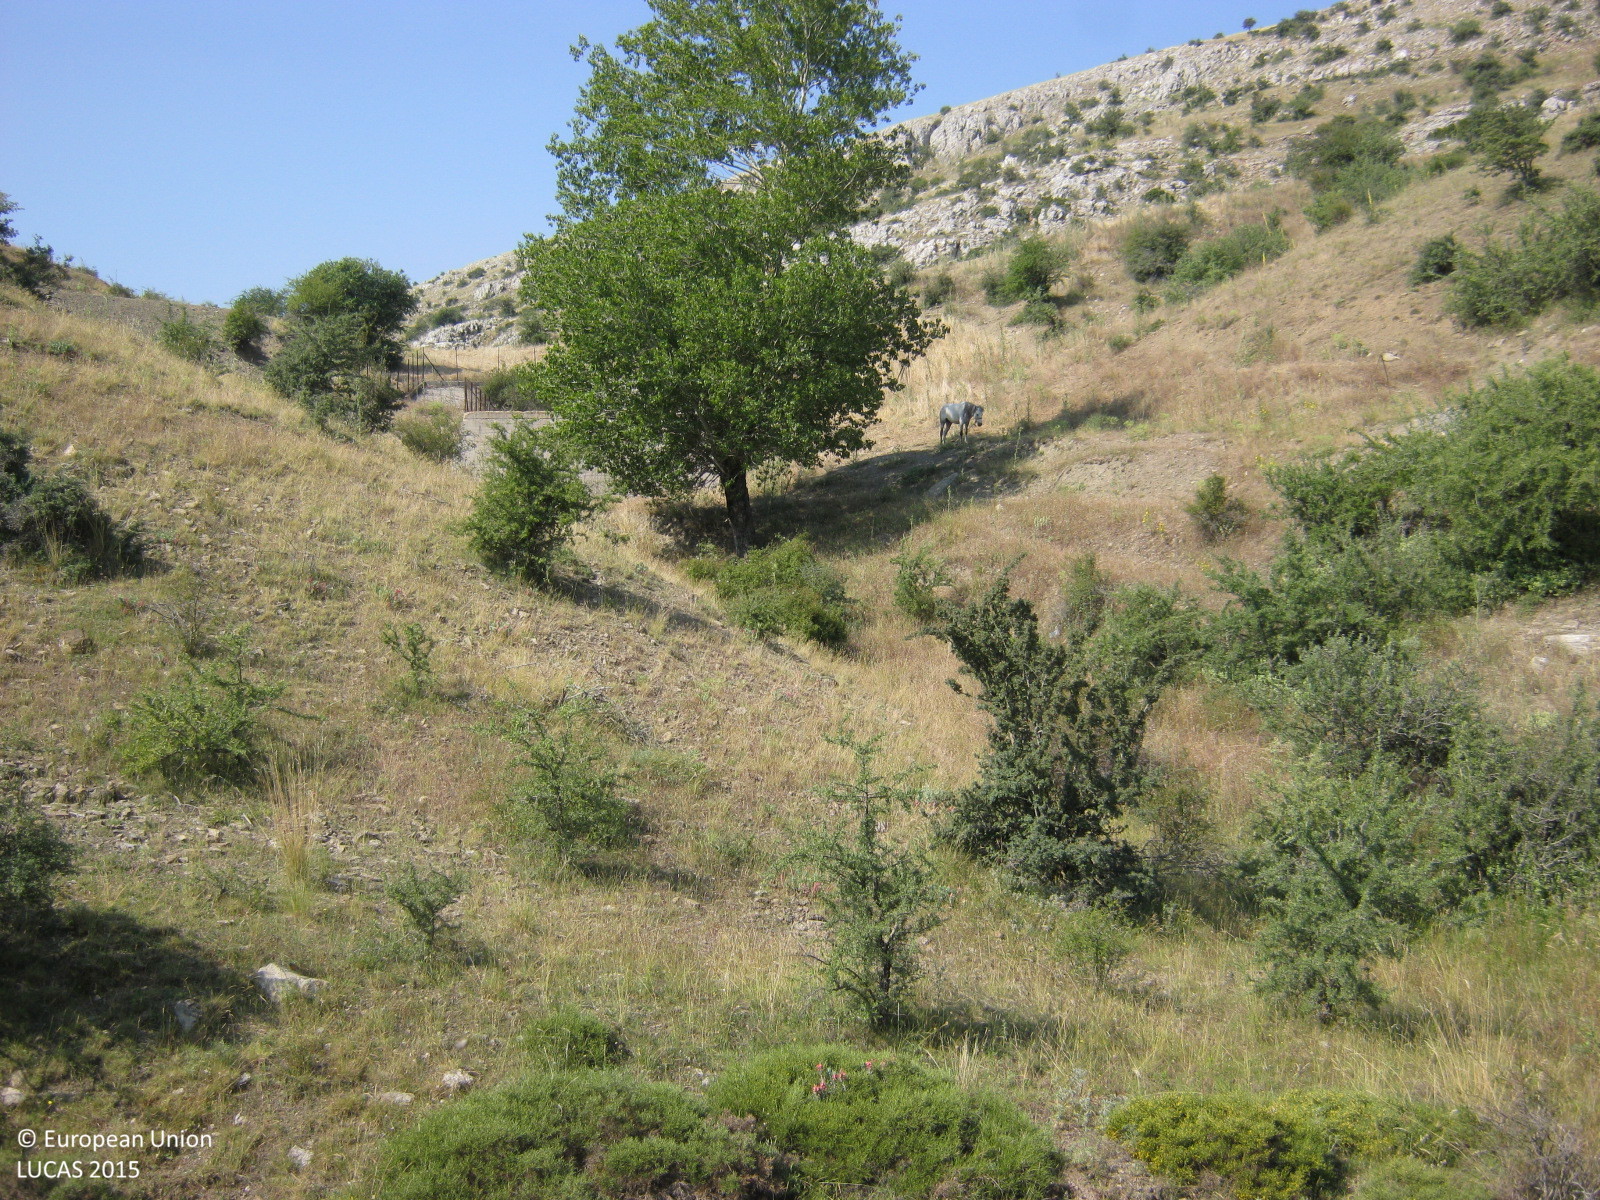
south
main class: Shrubland
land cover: Shrubland without tree cover
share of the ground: 50 - 75 %
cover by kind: shrubs 55 %, unconsolidated bare surface 25 %, herbaceous plants 20 %
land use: Semi-natural and natural areas not in use
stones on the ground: > 50 %
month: July
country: GR
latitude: 37.3616
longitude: 22.4819
